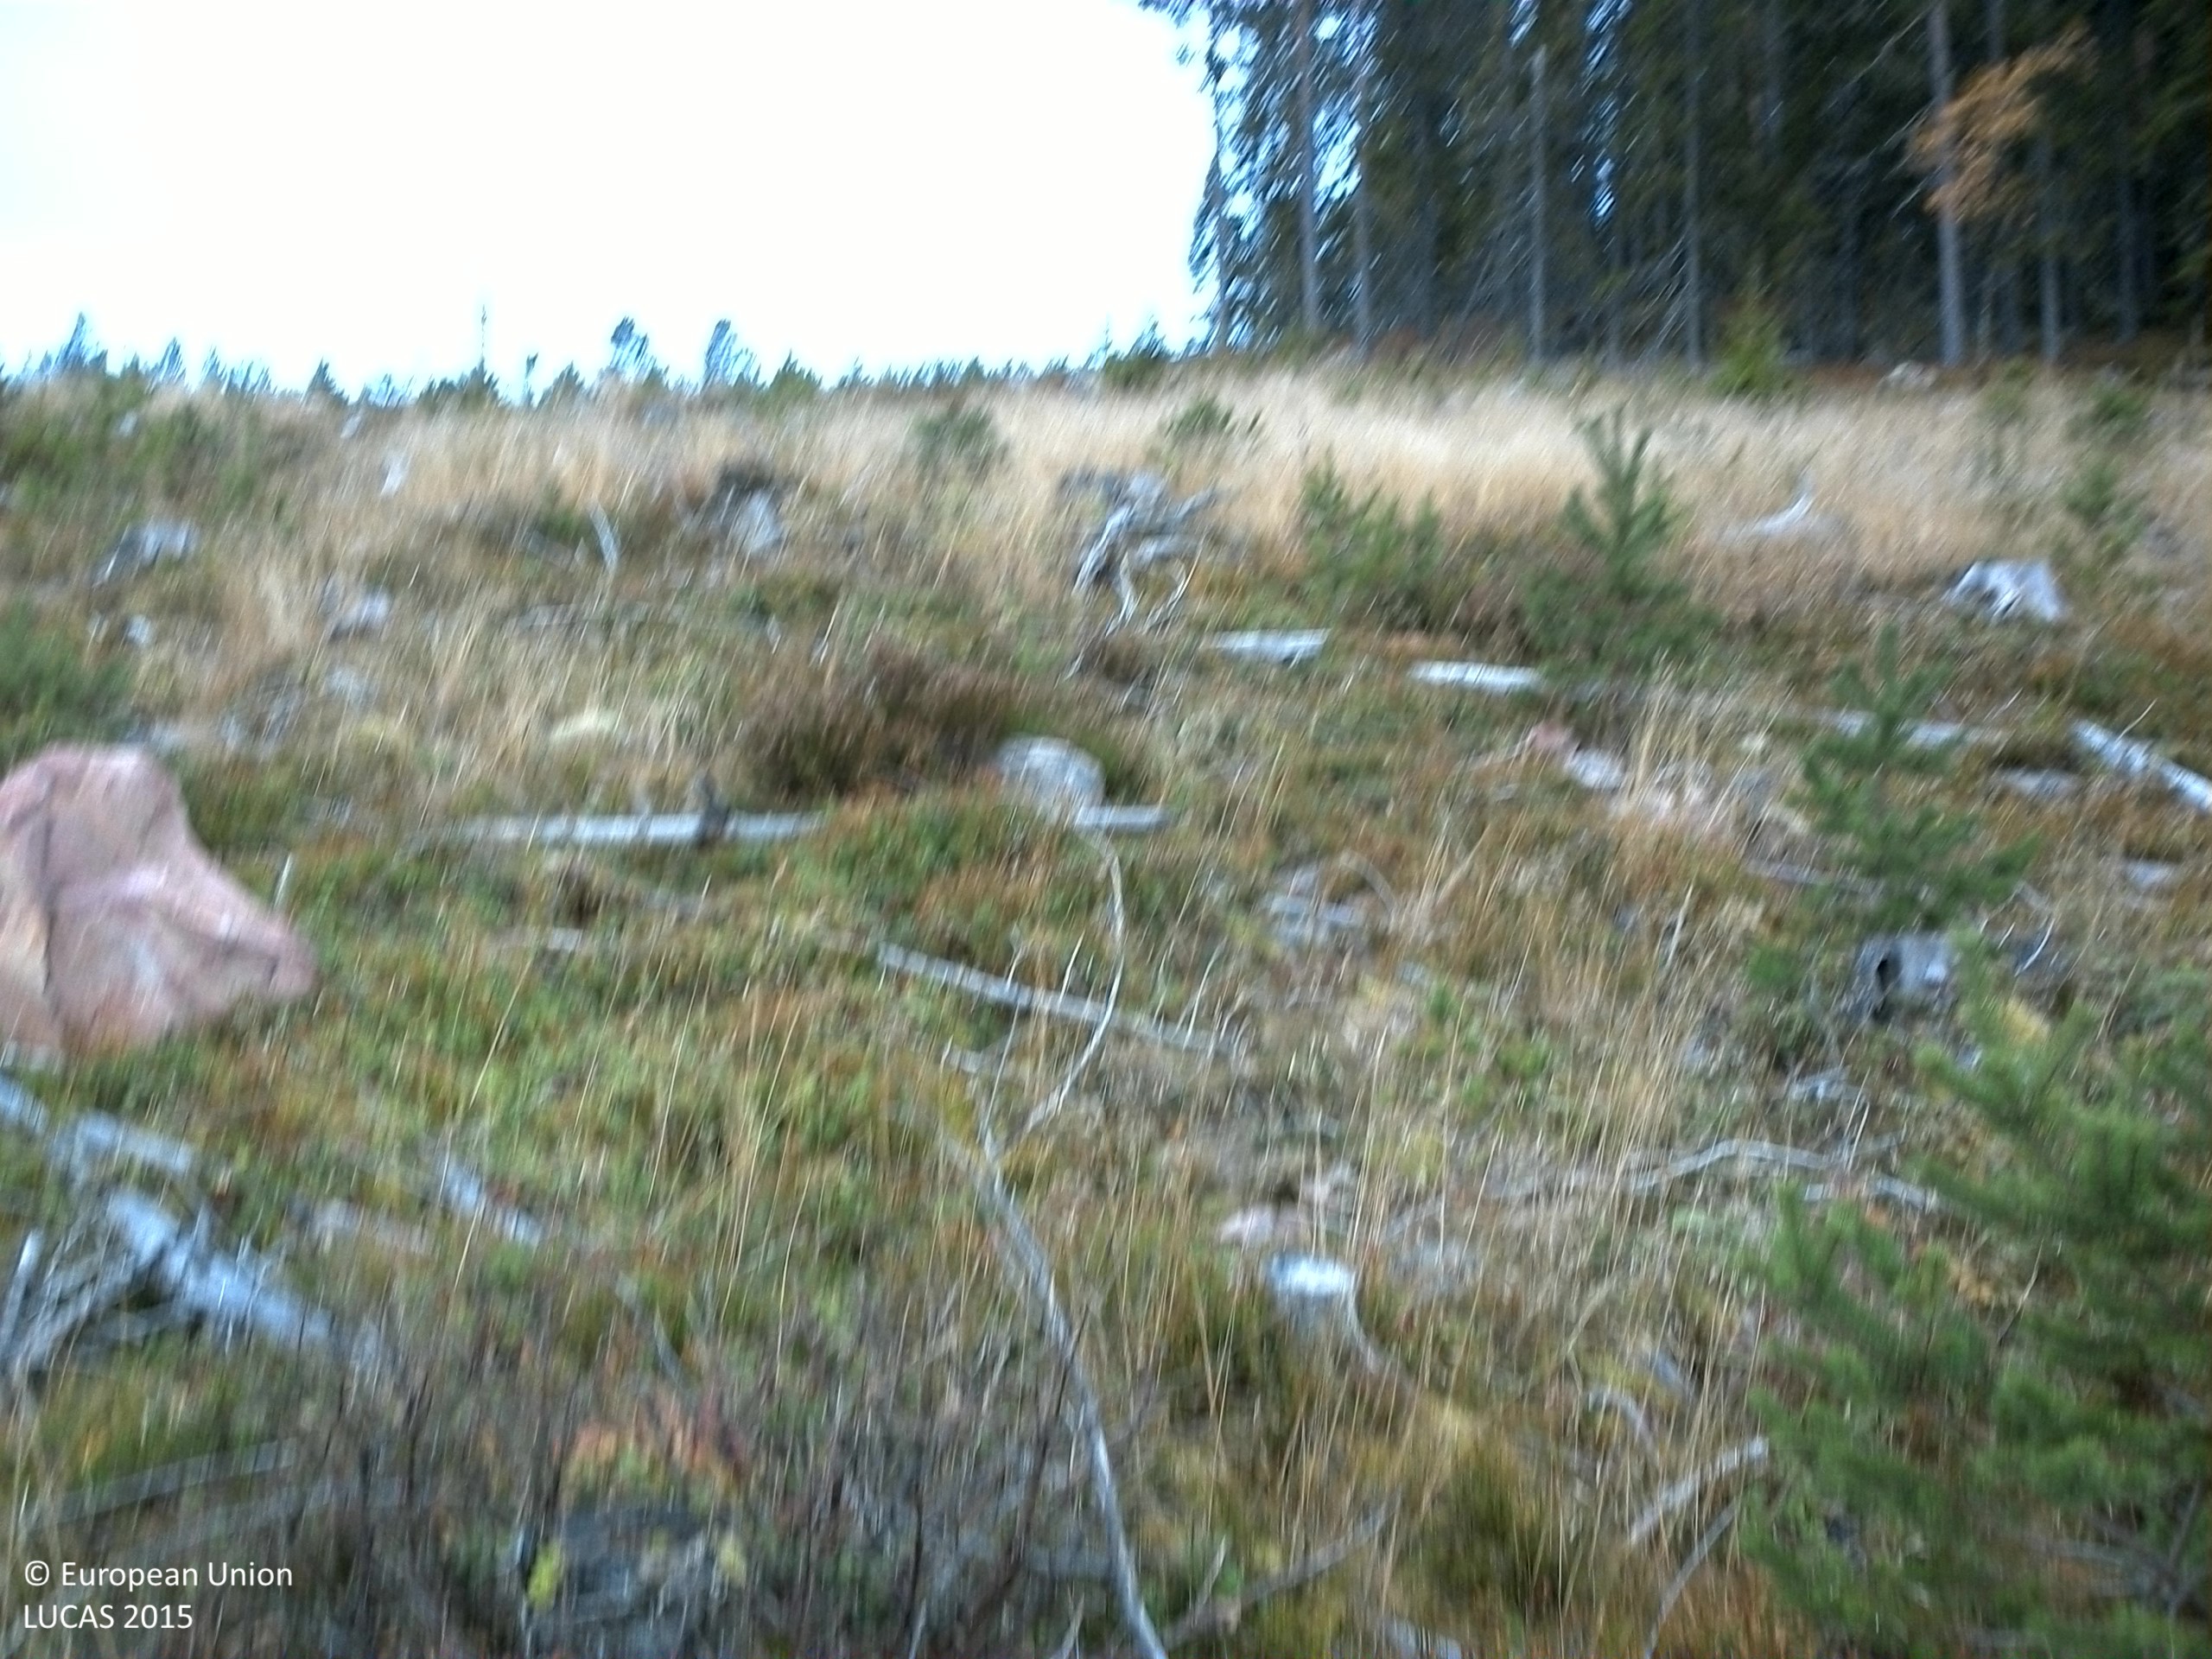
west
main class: Woodland
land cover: Pine dominated coniferous woodland
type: boreal forest
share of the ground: 25 - 50 %
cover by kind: shrubs 55 %, coniferous forest trees 25 %, herbaceous plants 10 %, lichens and mosses 10 %
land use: Forestry
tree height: < 5 m
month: October
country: SE
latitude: 61.2674
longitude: 14.3683
